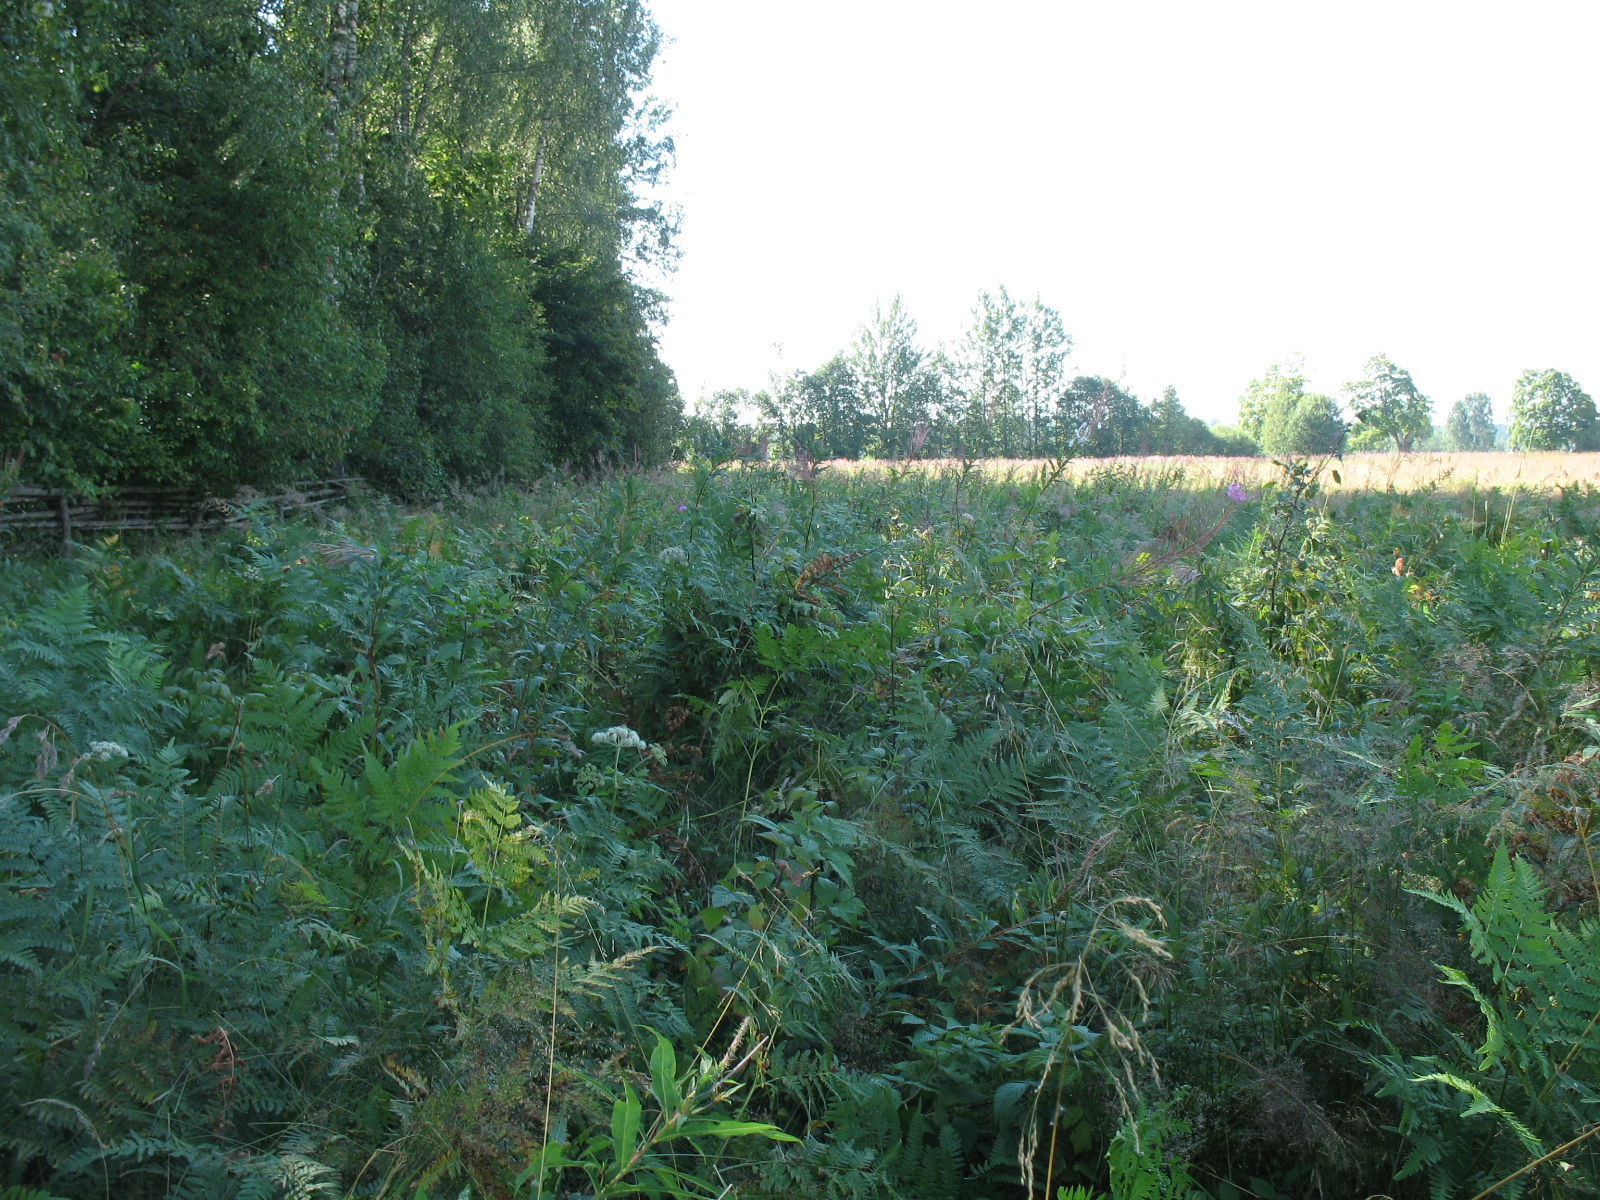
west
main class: Grassland
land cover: Spontaneously vegetated surfaces
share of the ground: > 75 %
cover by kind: herbaceous plants 100 %
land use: Agriculture (excluding fallow land and kitchen gardens)
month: August
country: LV
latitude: 56.5513
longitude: 25.2586
